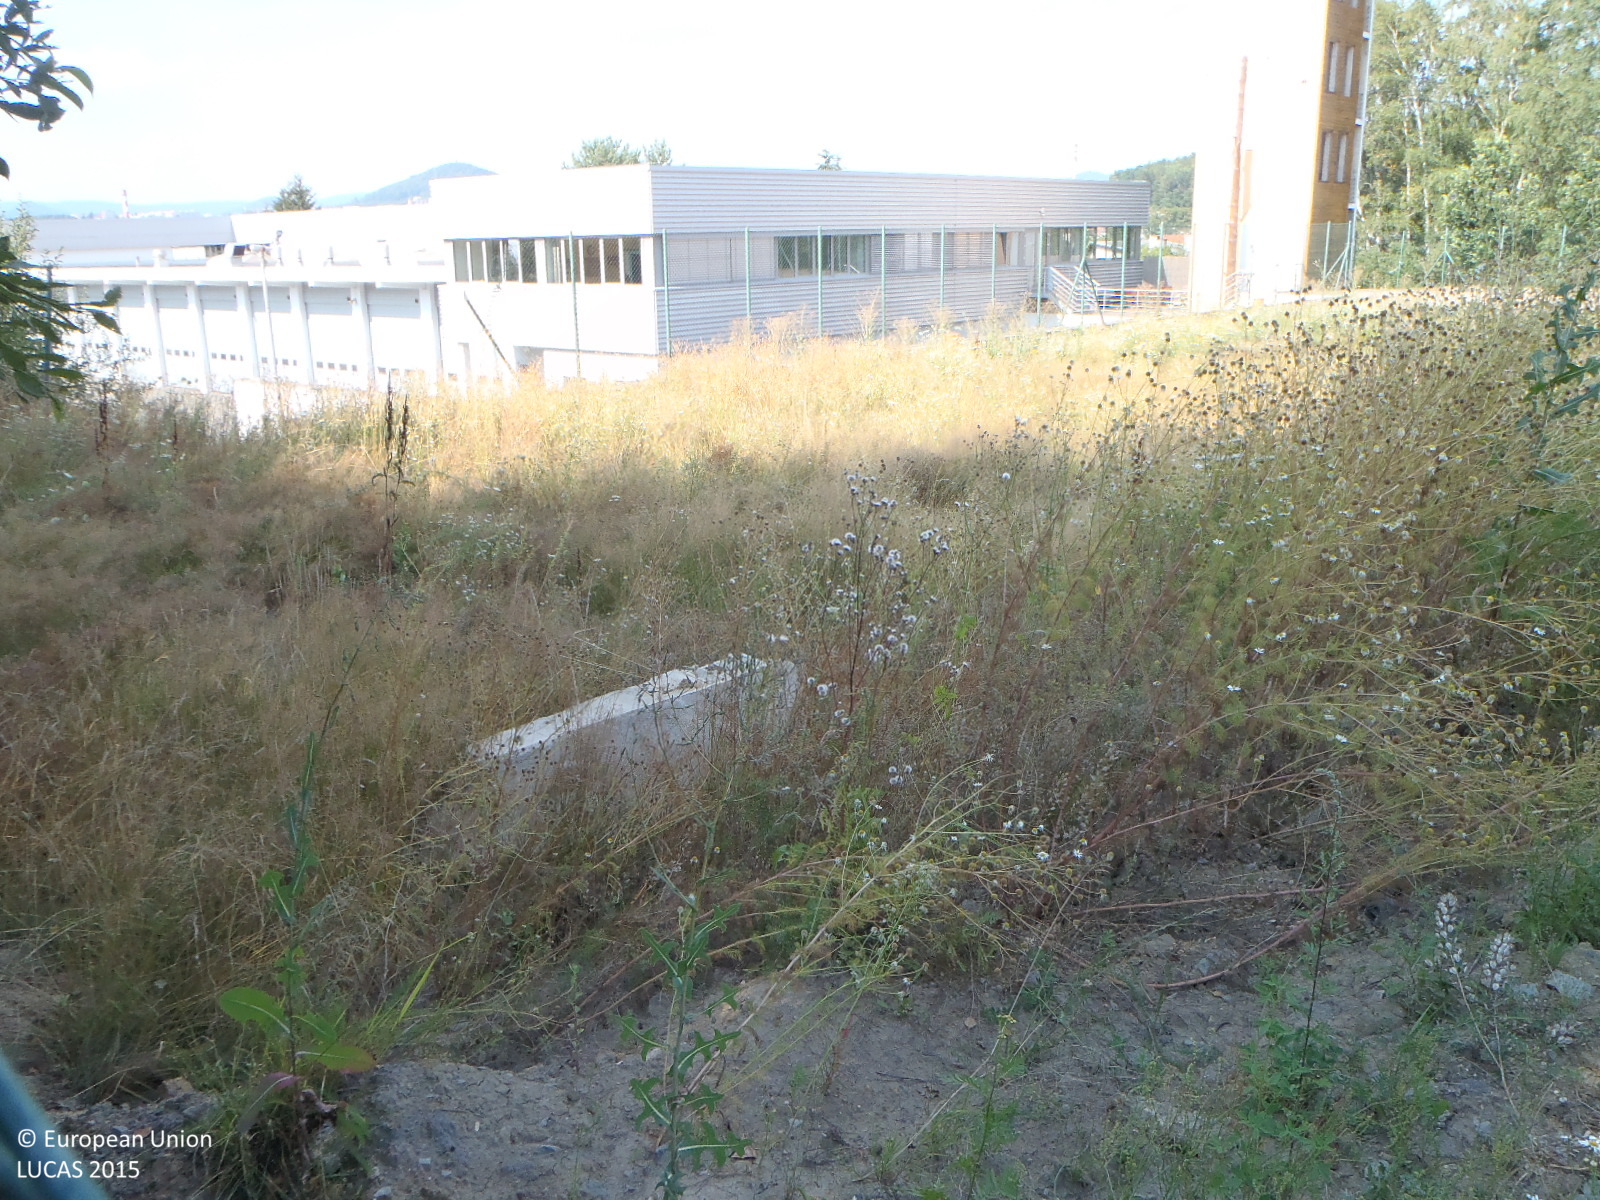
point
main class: Grassland
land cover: Spontaneously vegetated surfaces
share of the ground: > 75 %
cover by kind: herbaceous plants 95 %, unconsolidated bare surface 5 %
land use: Community services
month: August
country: CZ
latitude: 50.6700
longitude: 14.5438
